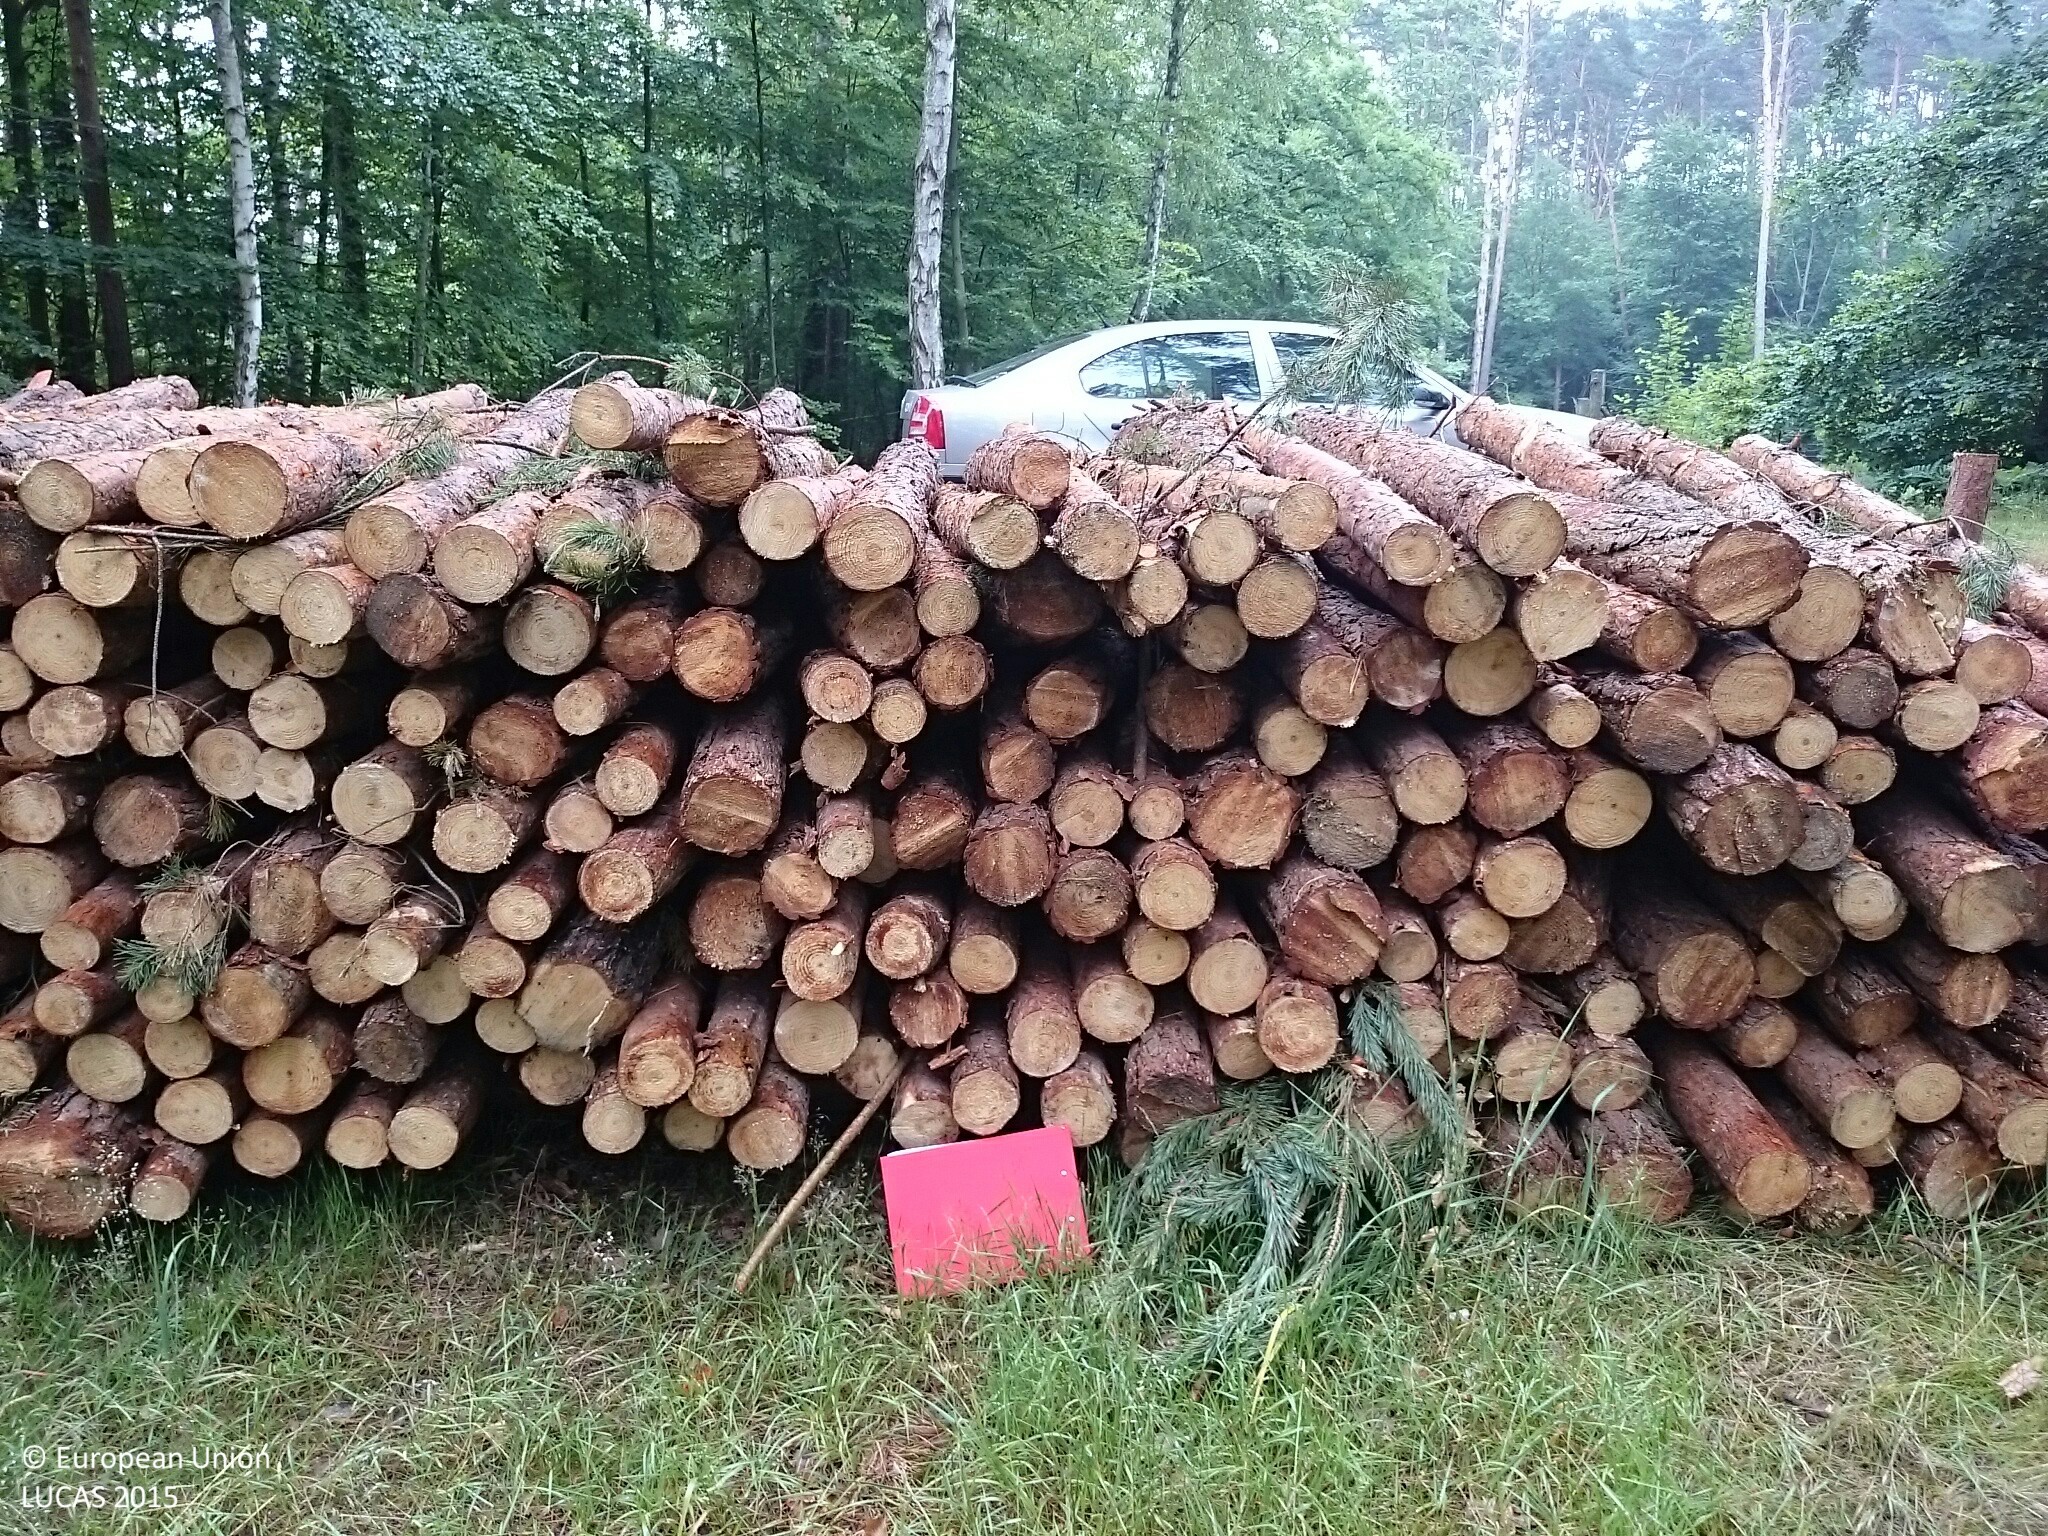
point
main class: Woodland
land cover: Pine dominated coniferous woodland
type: hemiboreal forest and nemoral coniferous forest and mixed broadleaved-coniferous forest
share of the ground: > 75 %
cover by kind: coniferous forest trees 90 %, broadleaved forest trees 5 %, consolidated bare surface 5 %
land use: Forestry
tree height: > 5 m
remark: Clear cut
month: June
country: PL
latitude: 52.9253
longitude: 15.7014
